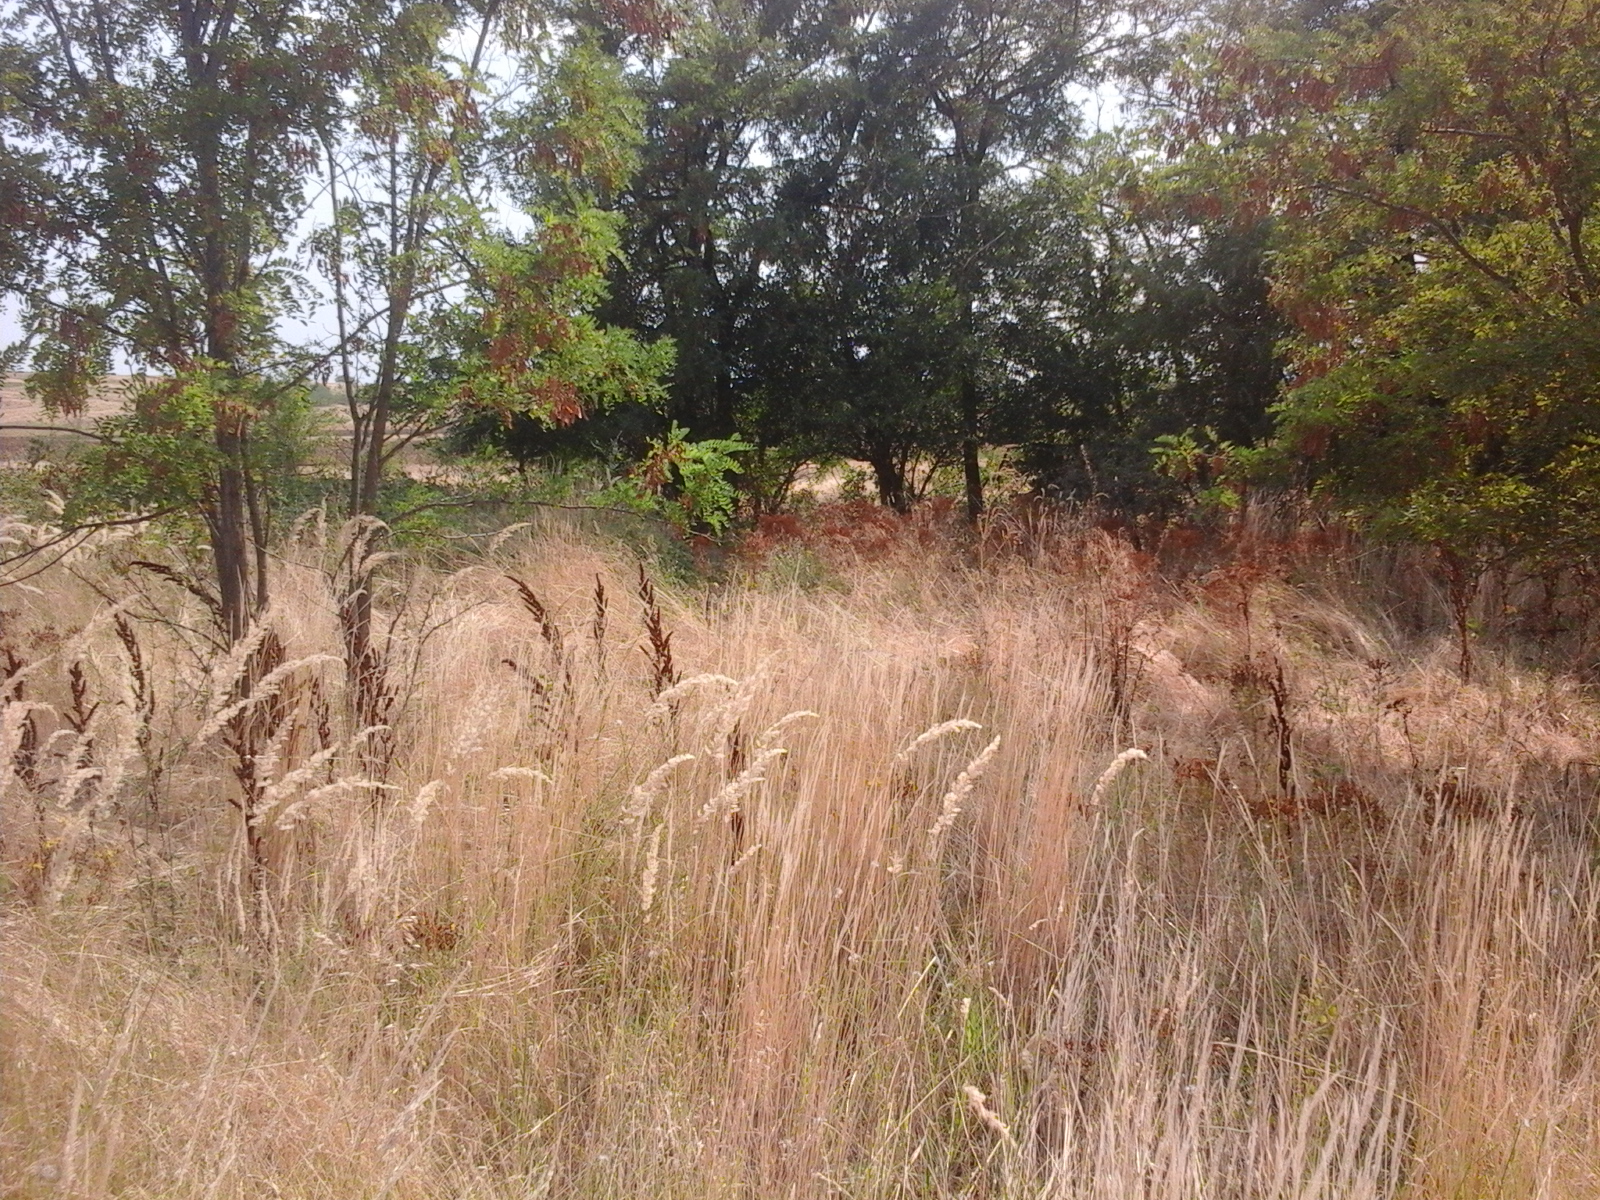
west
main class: Grassland
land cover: Grassland without tree/shrub cover
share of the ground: > 75 %
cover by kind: herbaceous plants 100 %
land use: Agriculture (excluding fallow land and kitchen gardens)
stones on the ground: < 10 %
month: August
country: RO
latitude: 44.4754
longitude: 22.7261
